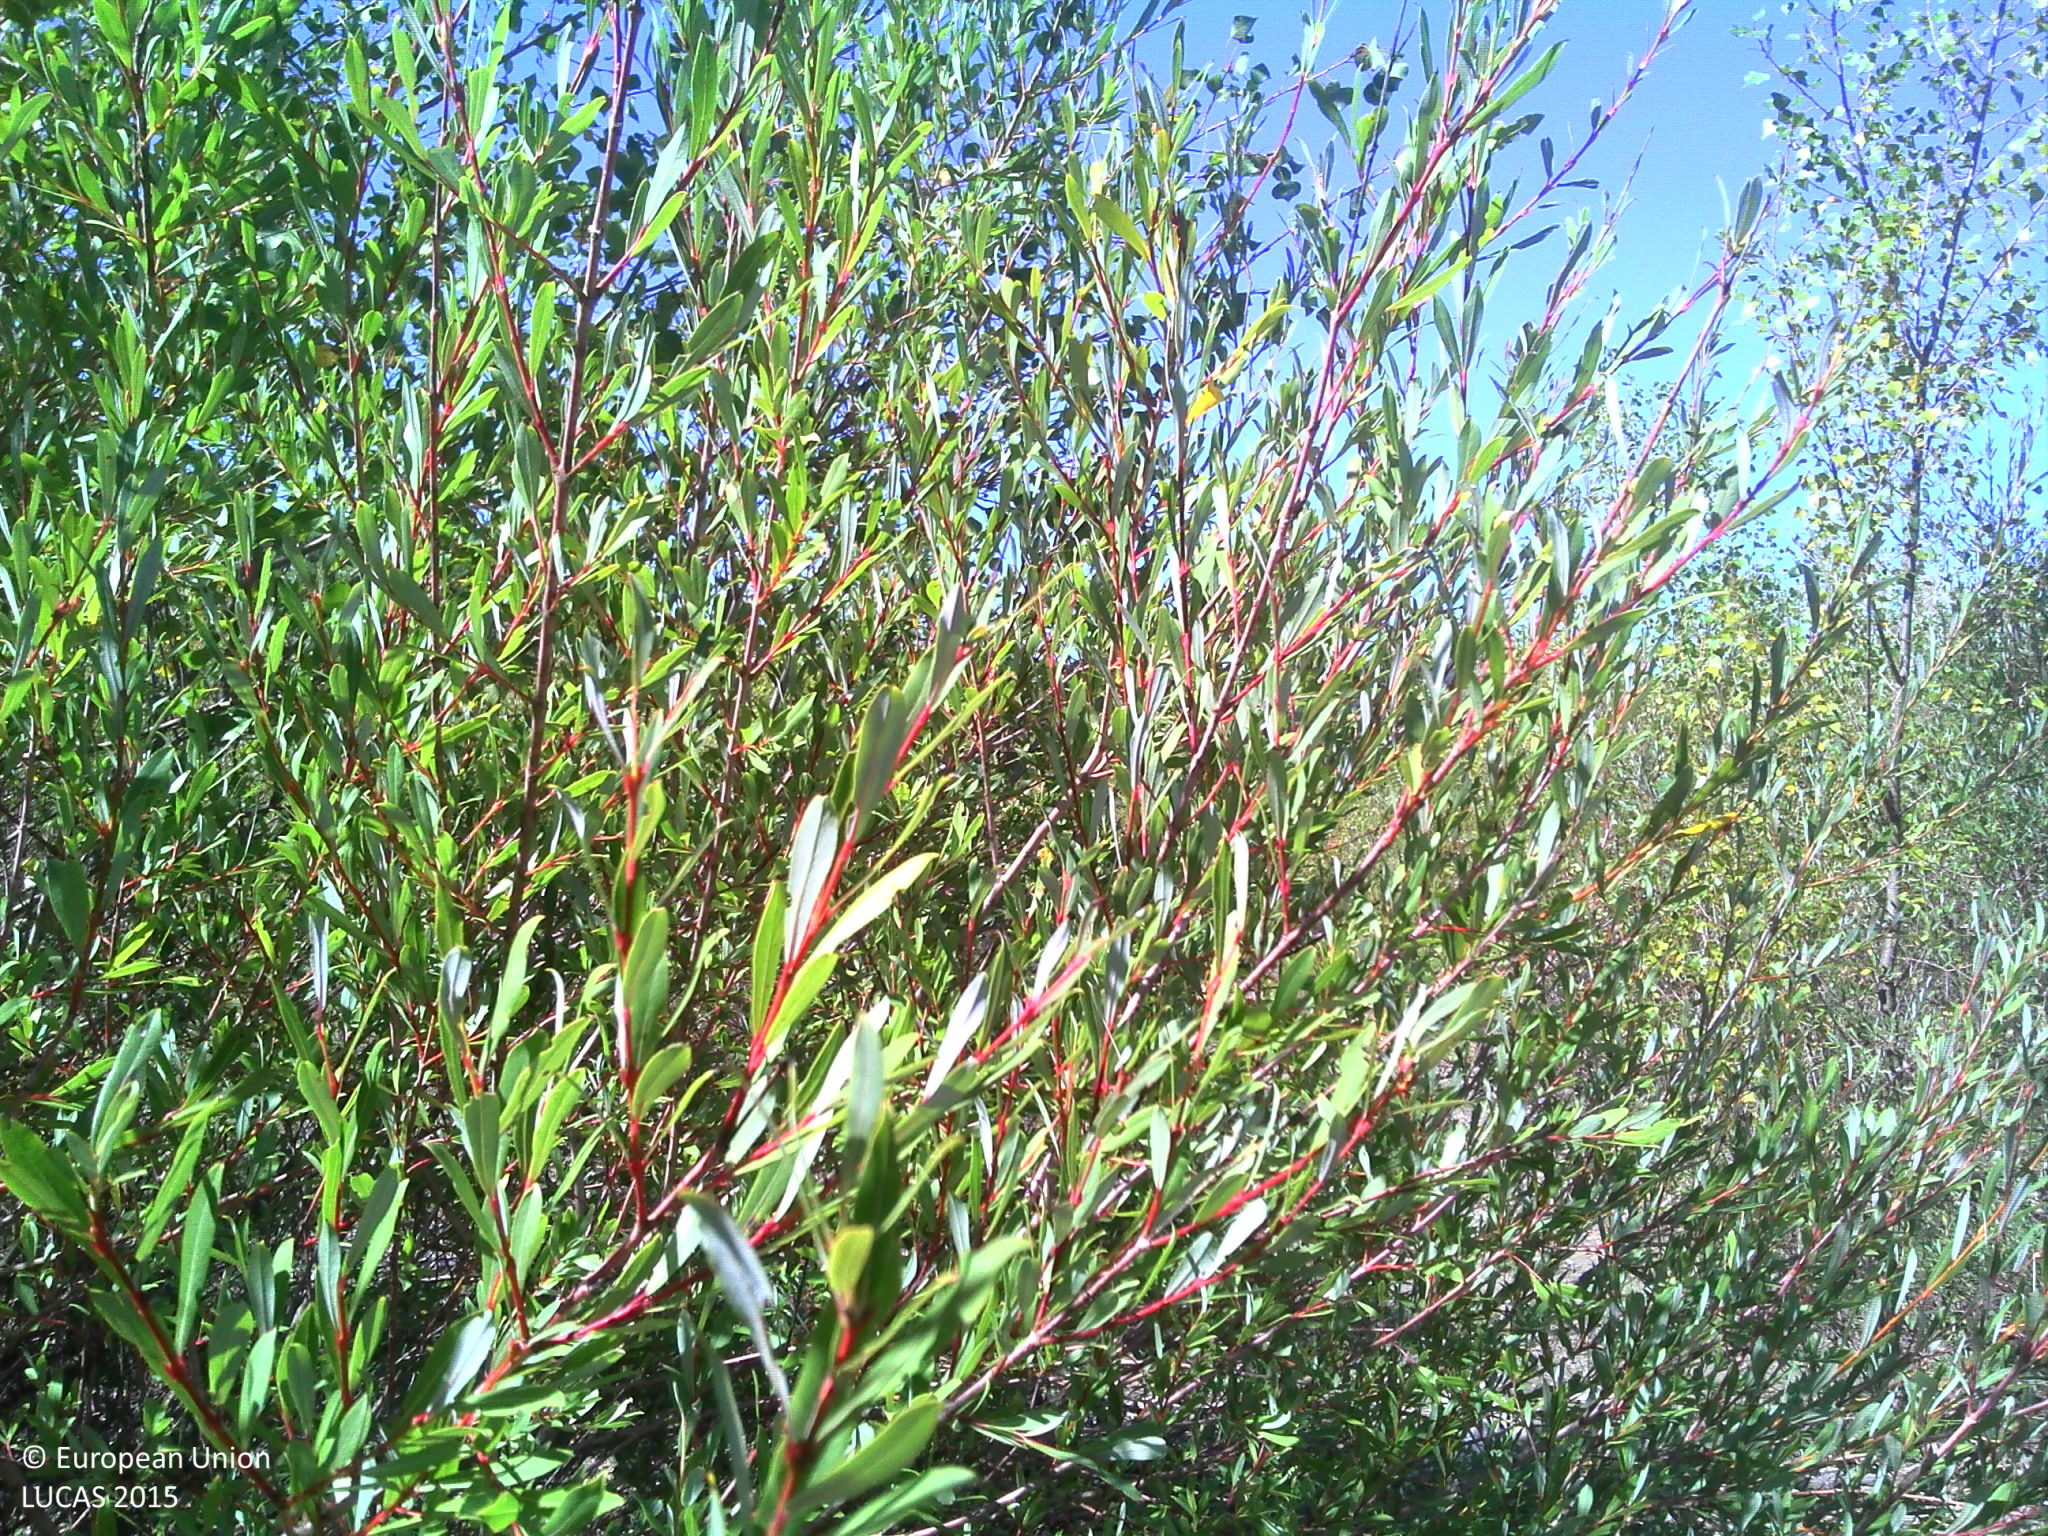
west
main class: Woodland
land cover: Broadleaved woodland
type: thermophilous deciduous forest
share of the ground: 25 - 50 %
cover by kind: broadleaved forest trees 50 %, unconsolidated bare surface 35 %, consolidated bare surface 10 %, coniferous forest trees 5 %
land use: Semi-natural and natural areas not in use
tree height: > 5 m
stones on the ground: < 10 %
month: September
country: FR
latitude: 44.3852
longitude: 5.2249
